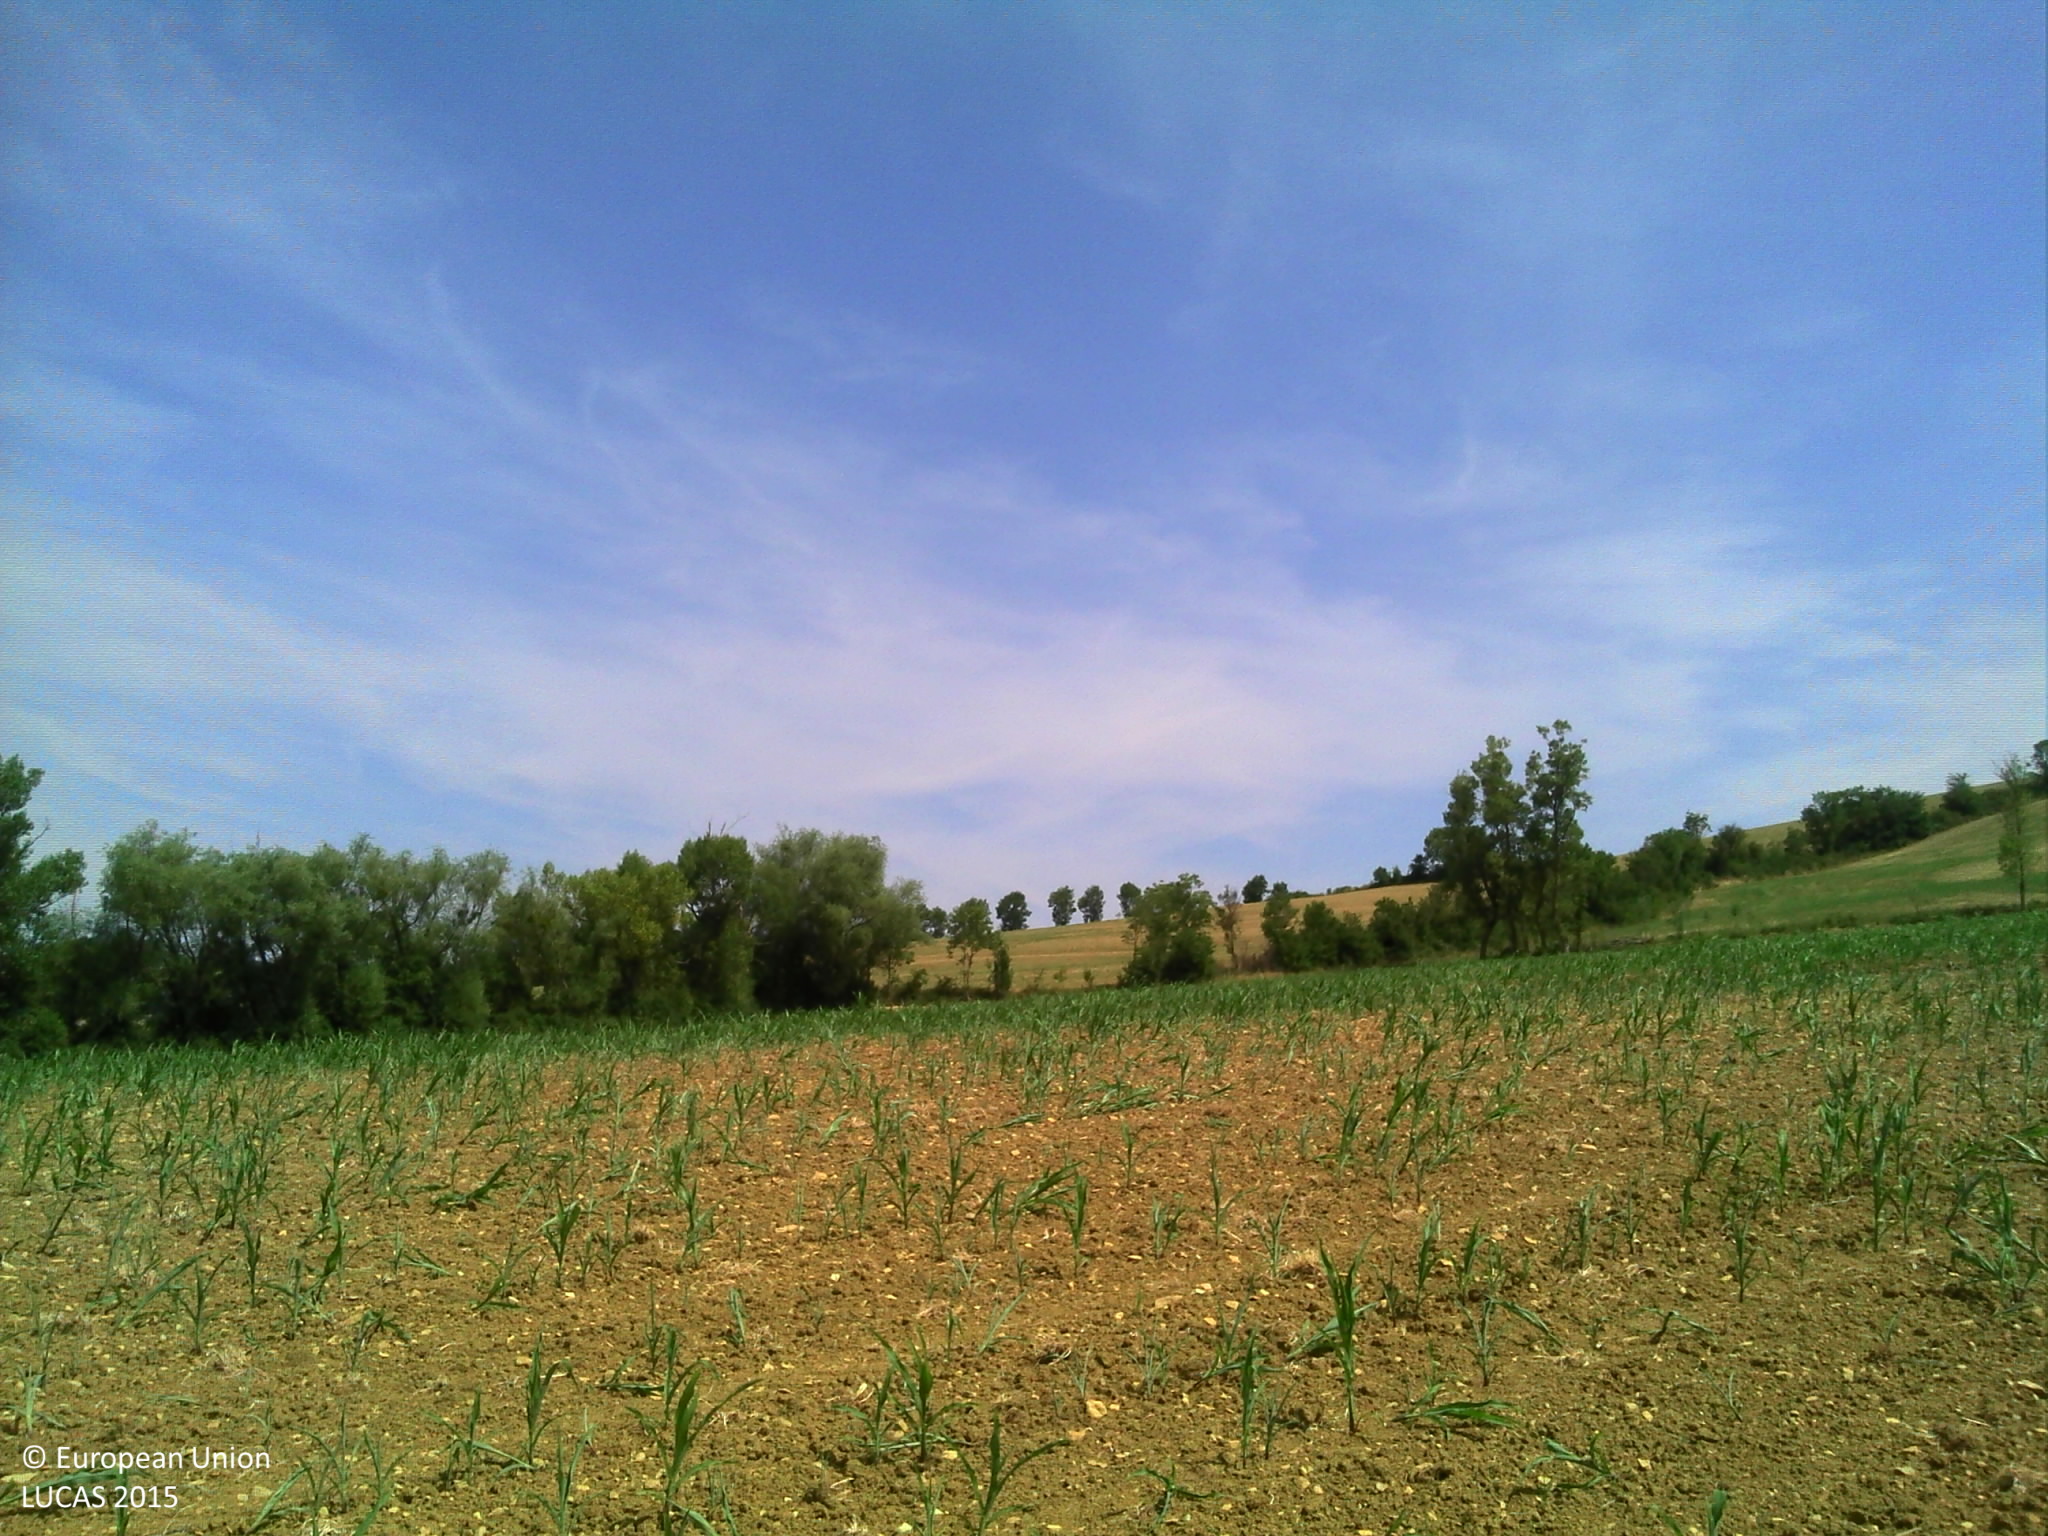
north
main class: Cropland
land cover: Maize
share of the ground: 50 - 75 %
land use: Agriculture (excluding fallow land and kitchen gardens)
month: July
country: FR
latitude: 44.5122
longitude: 3.2746
